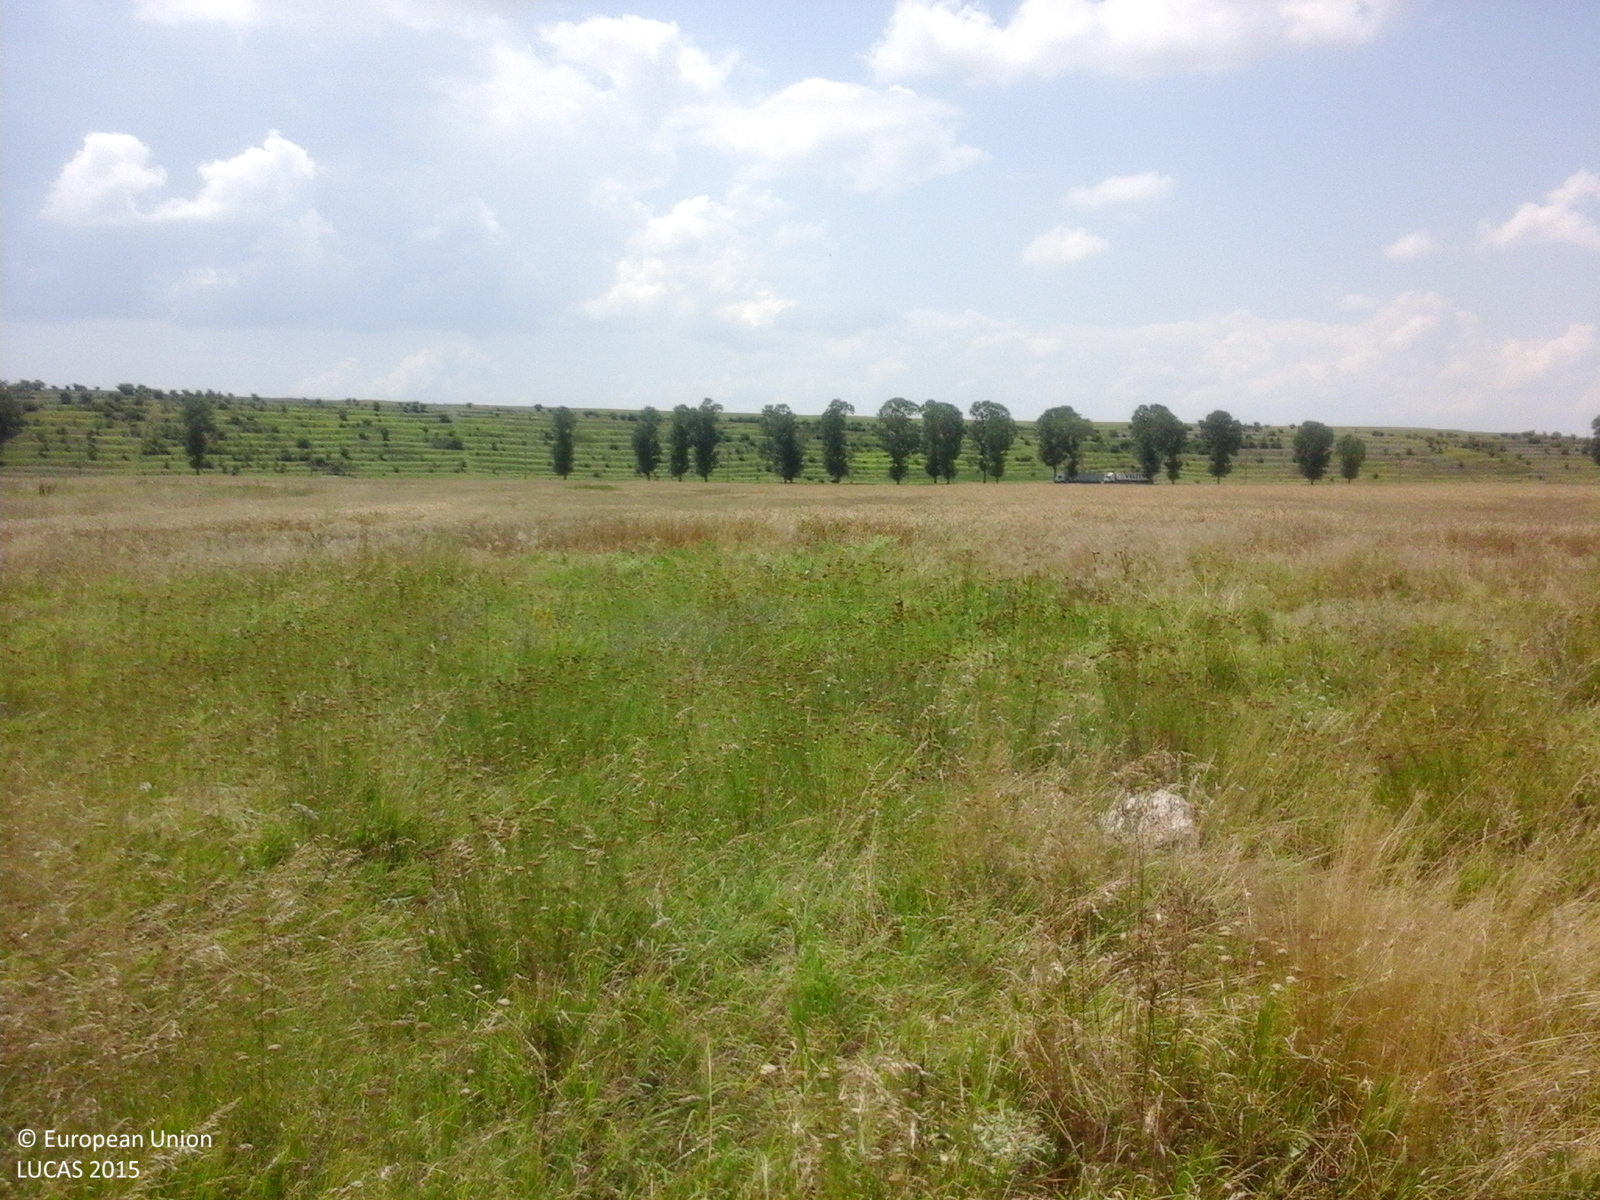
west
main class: Grassland
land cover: Grassland without tree/shrub cover
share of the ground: > 75 %
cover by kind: herbaceous plants 100 %
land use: Agriculture (excluding fallow land and kitchen gardens)
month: July
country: RO
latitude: 44.0441
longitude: 25.3471
